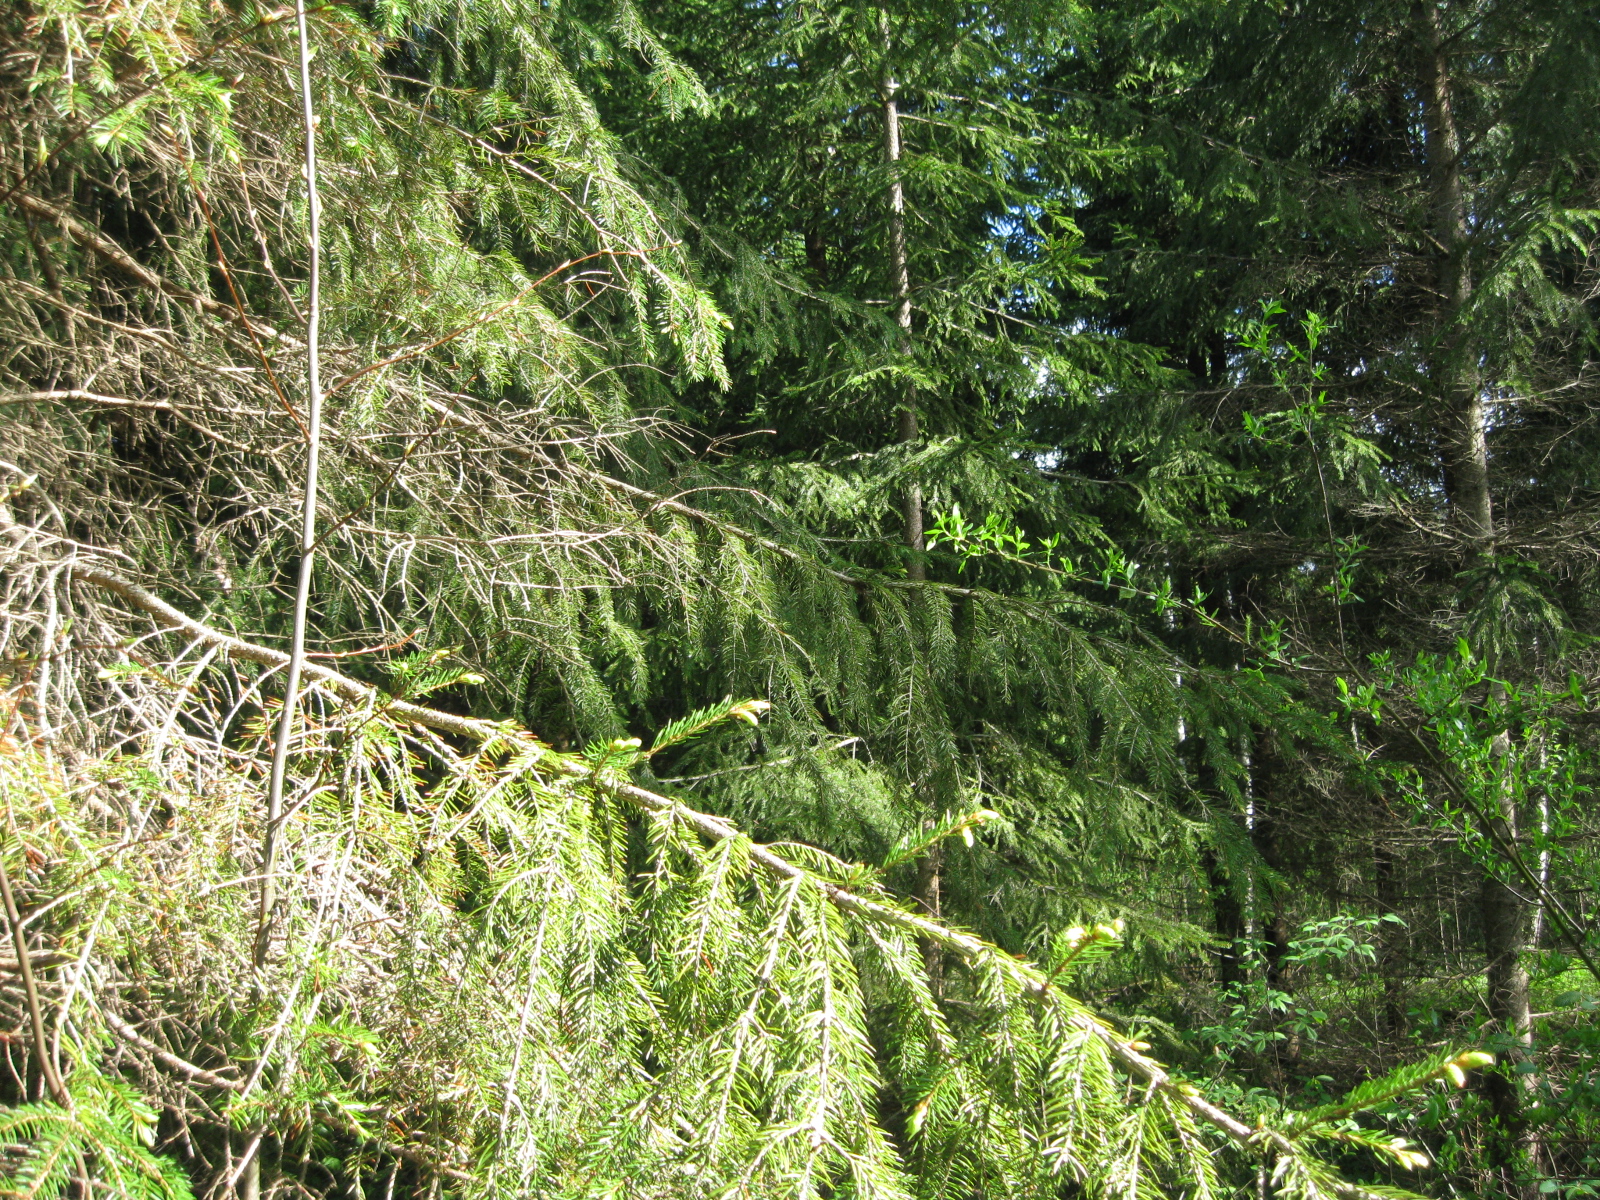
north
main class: Woodland
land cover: Spruce dominated mixed woodland
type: hemiboreal forest and nemoral coniferous forest and mixed broadleaved-coniferous forest
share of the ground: > 75 %
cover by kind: coniferous forest trees 60 %, broadleaved forest trees 25 %, herbaceous plants 15 %
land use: Forestry
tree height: > 5 m
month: May
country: LT
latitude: 56.2899
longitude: 24.9880
